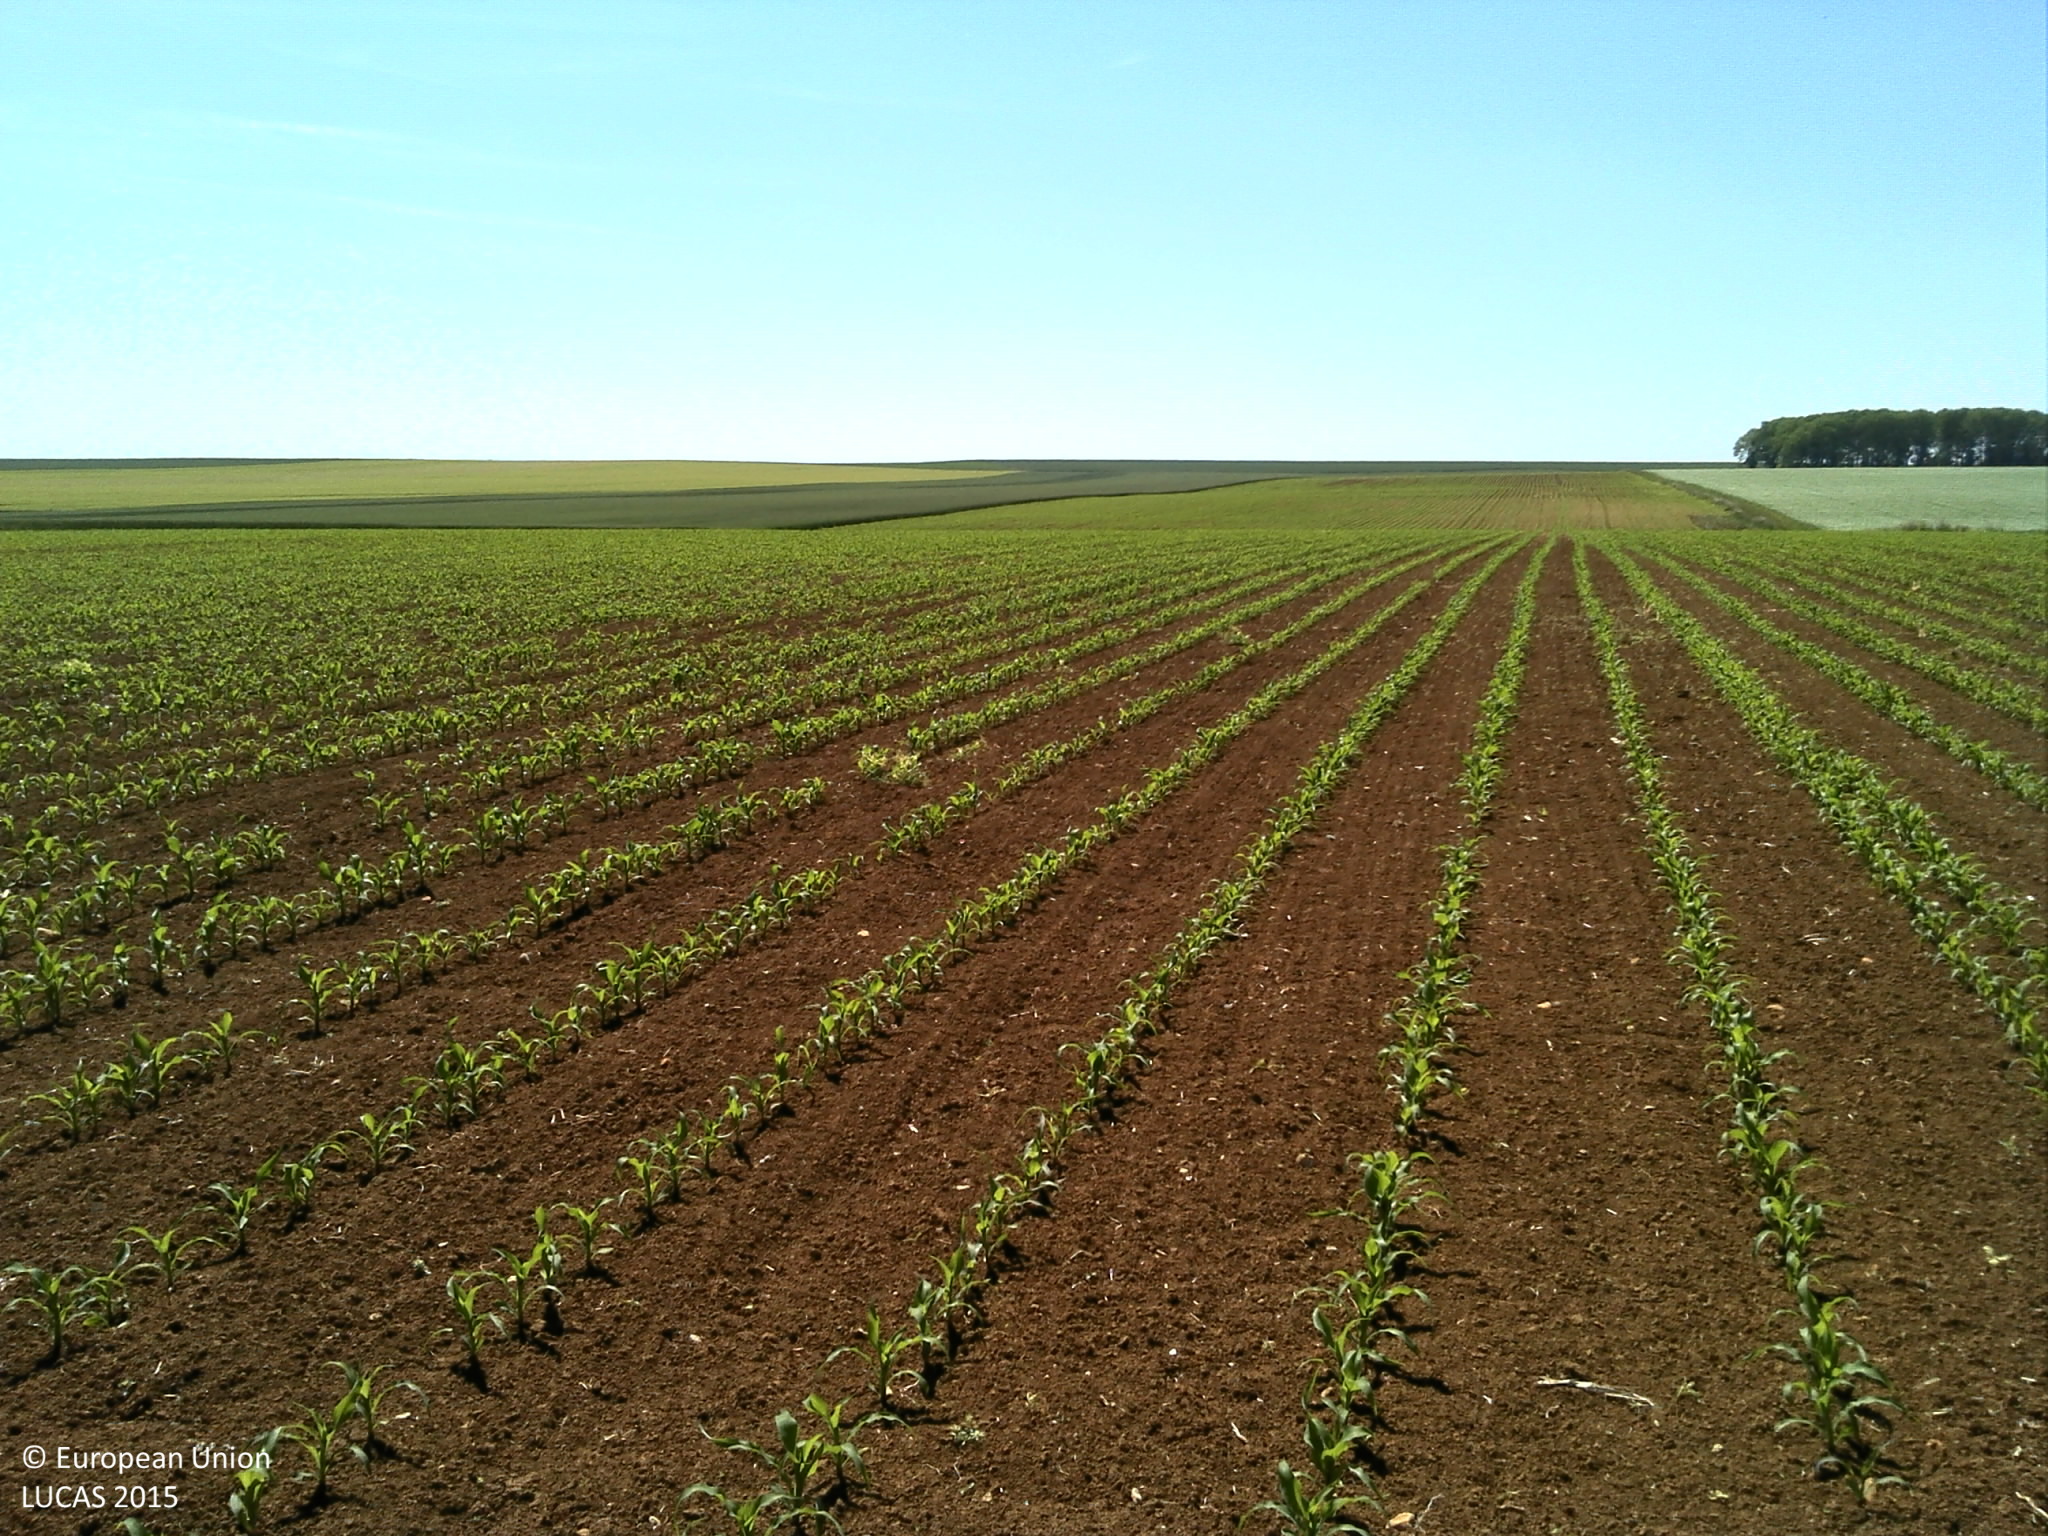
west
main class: Cropland
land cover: Maize
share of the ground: < 10 %
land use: Agriculture (excluding fallow land and kitchen gardens)
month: June
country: FR
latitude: 49.1052
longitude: 5.9860
